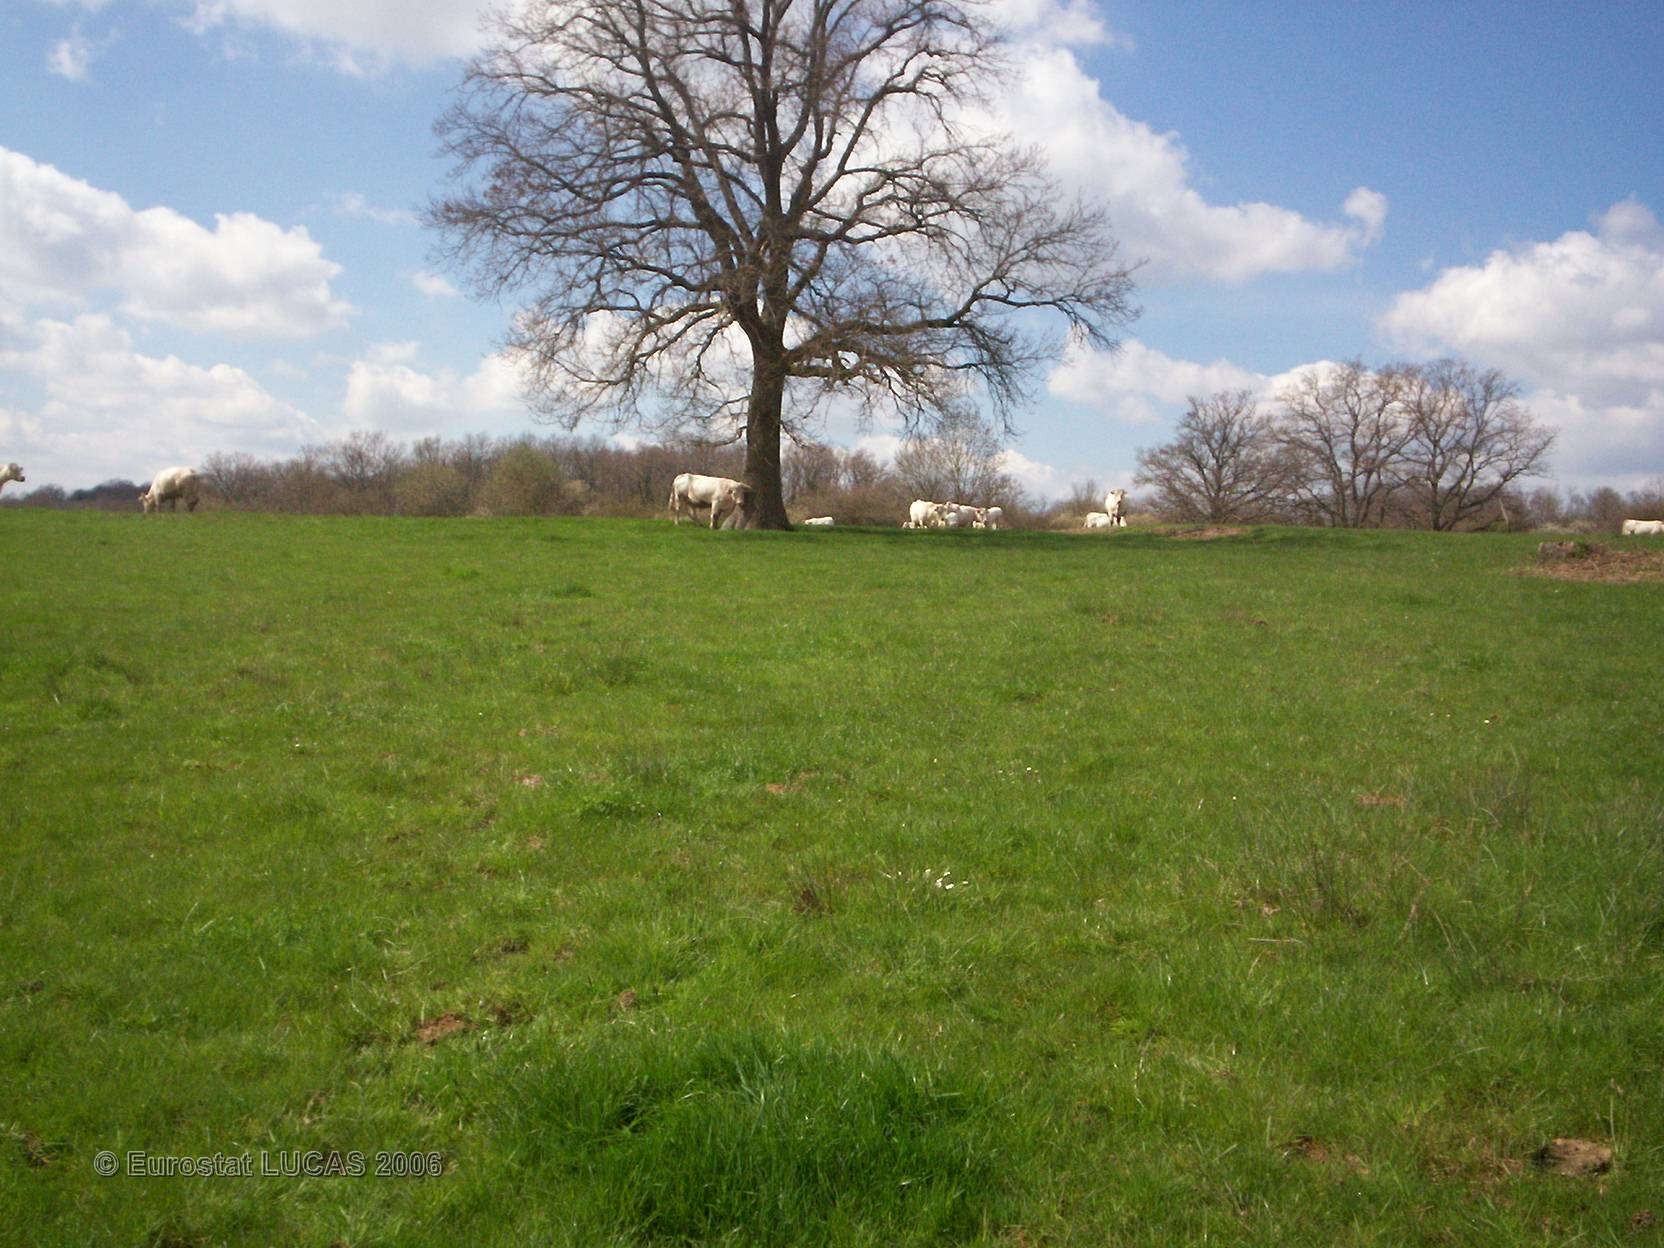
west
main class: Grassland
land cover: Grassland without tree/shrub cover
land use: Agriculture (excluding fallow land and kitchen gardens)
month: April
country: FR
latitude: 46.7606
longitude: 3.0968
